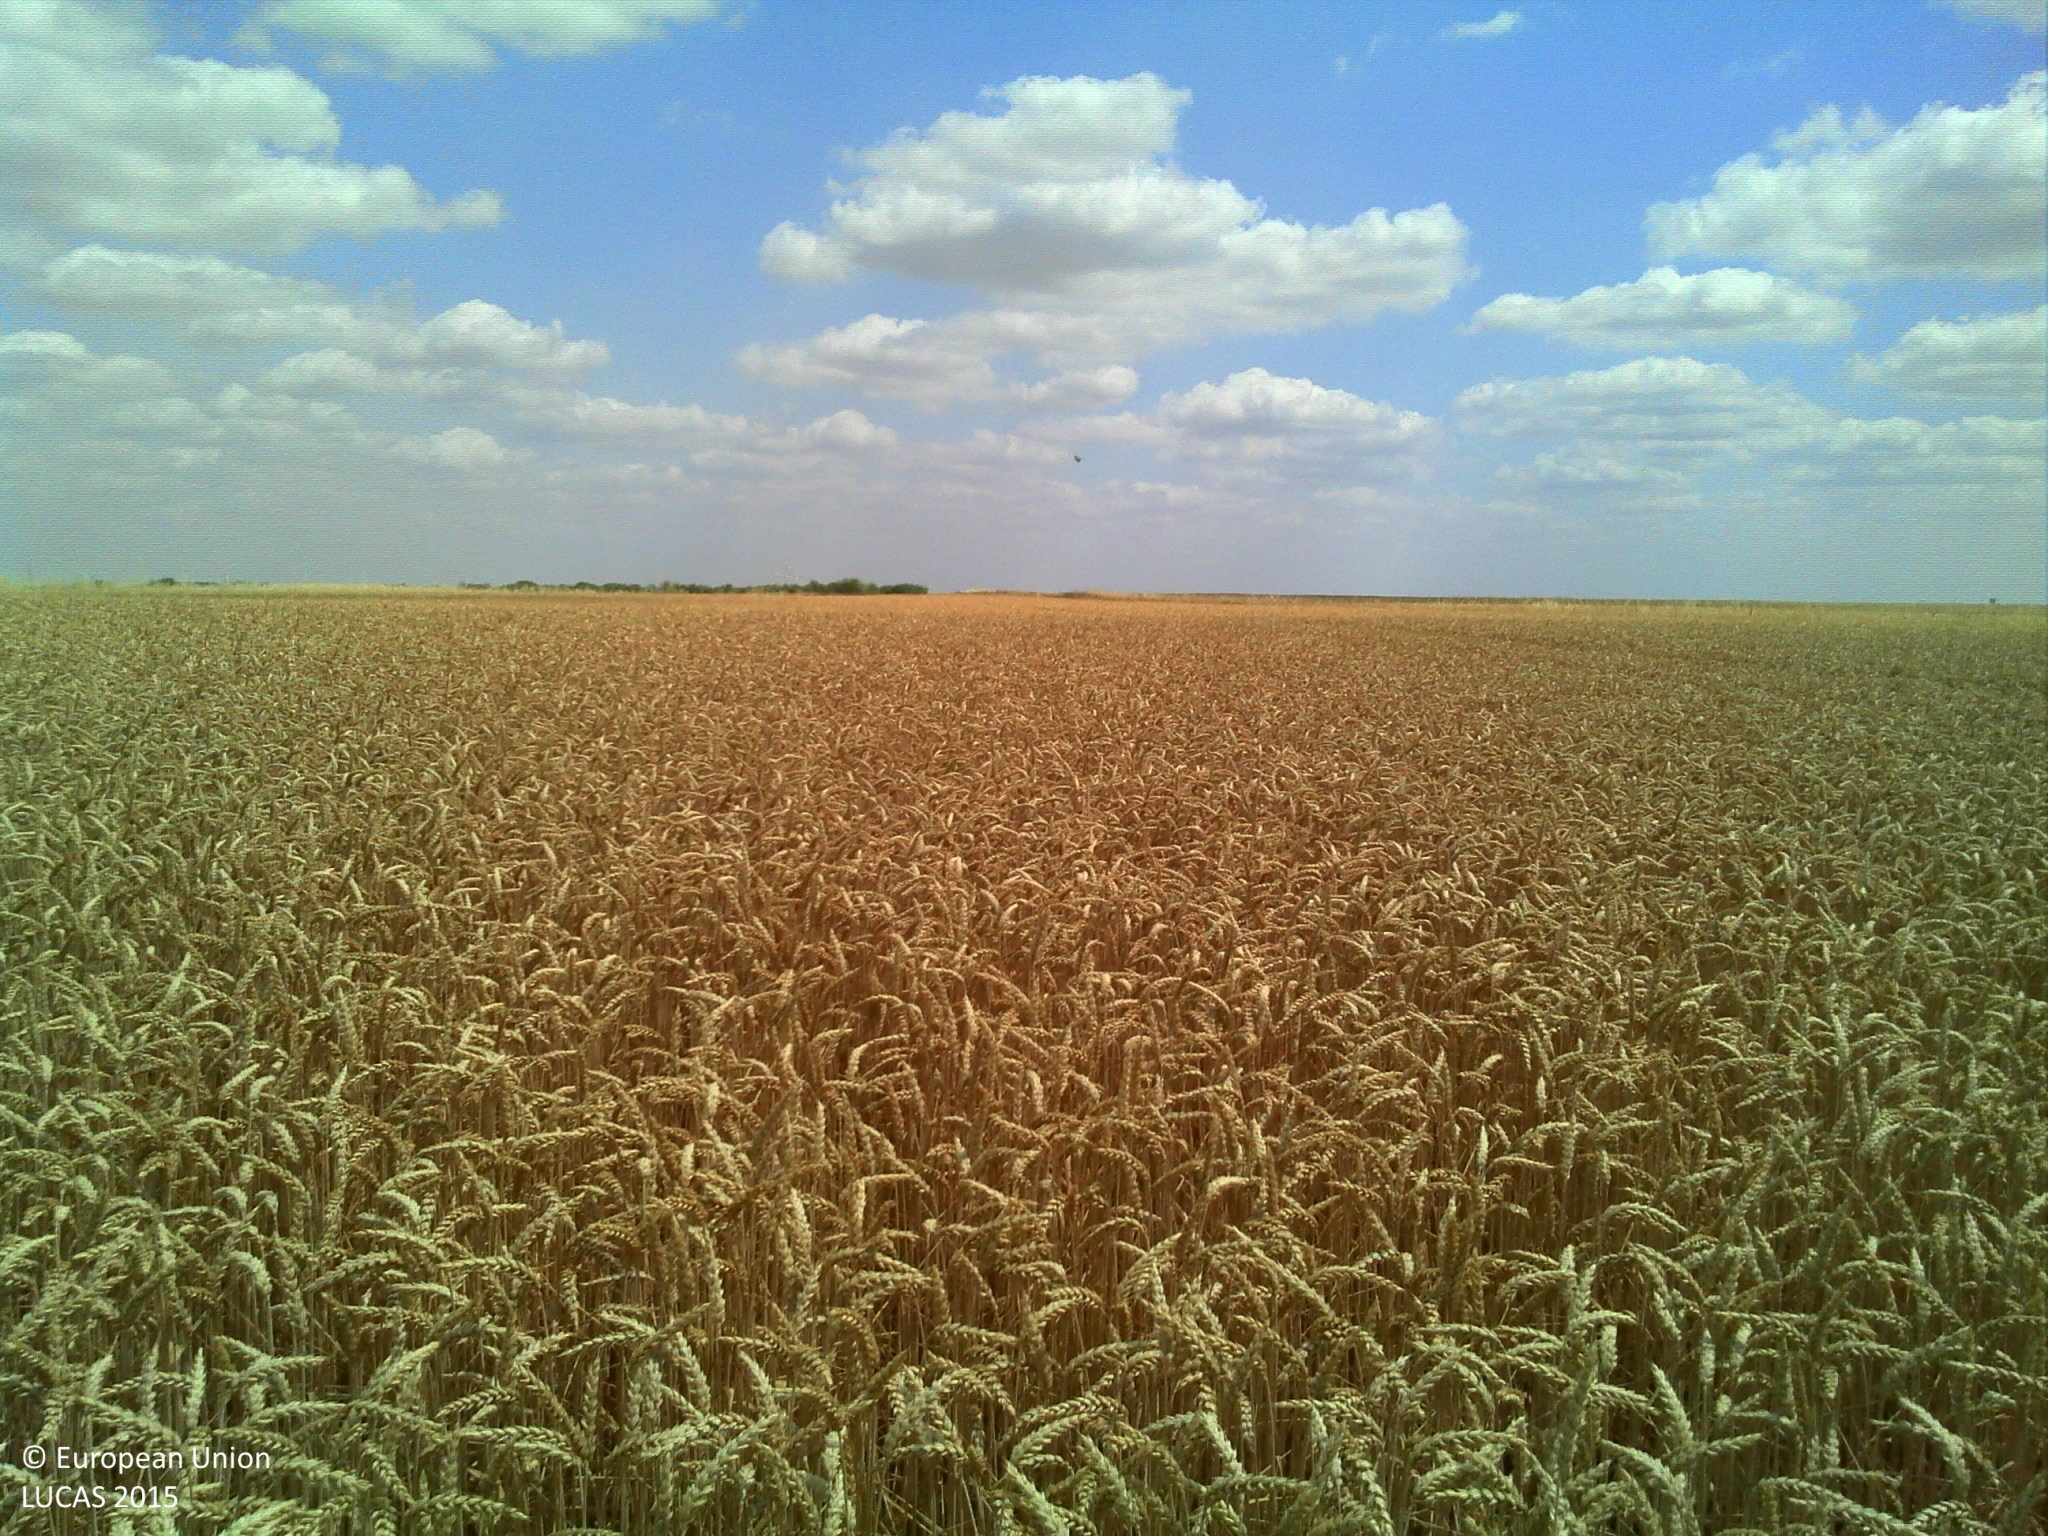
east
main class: Cropland
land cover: Common wheat
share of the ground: > 75 %
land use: Agriculture (excluding fallow land and kitchen gardens)
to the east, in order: Common wheat
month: July
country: FR
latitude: 48.0933
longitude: 2.4846
